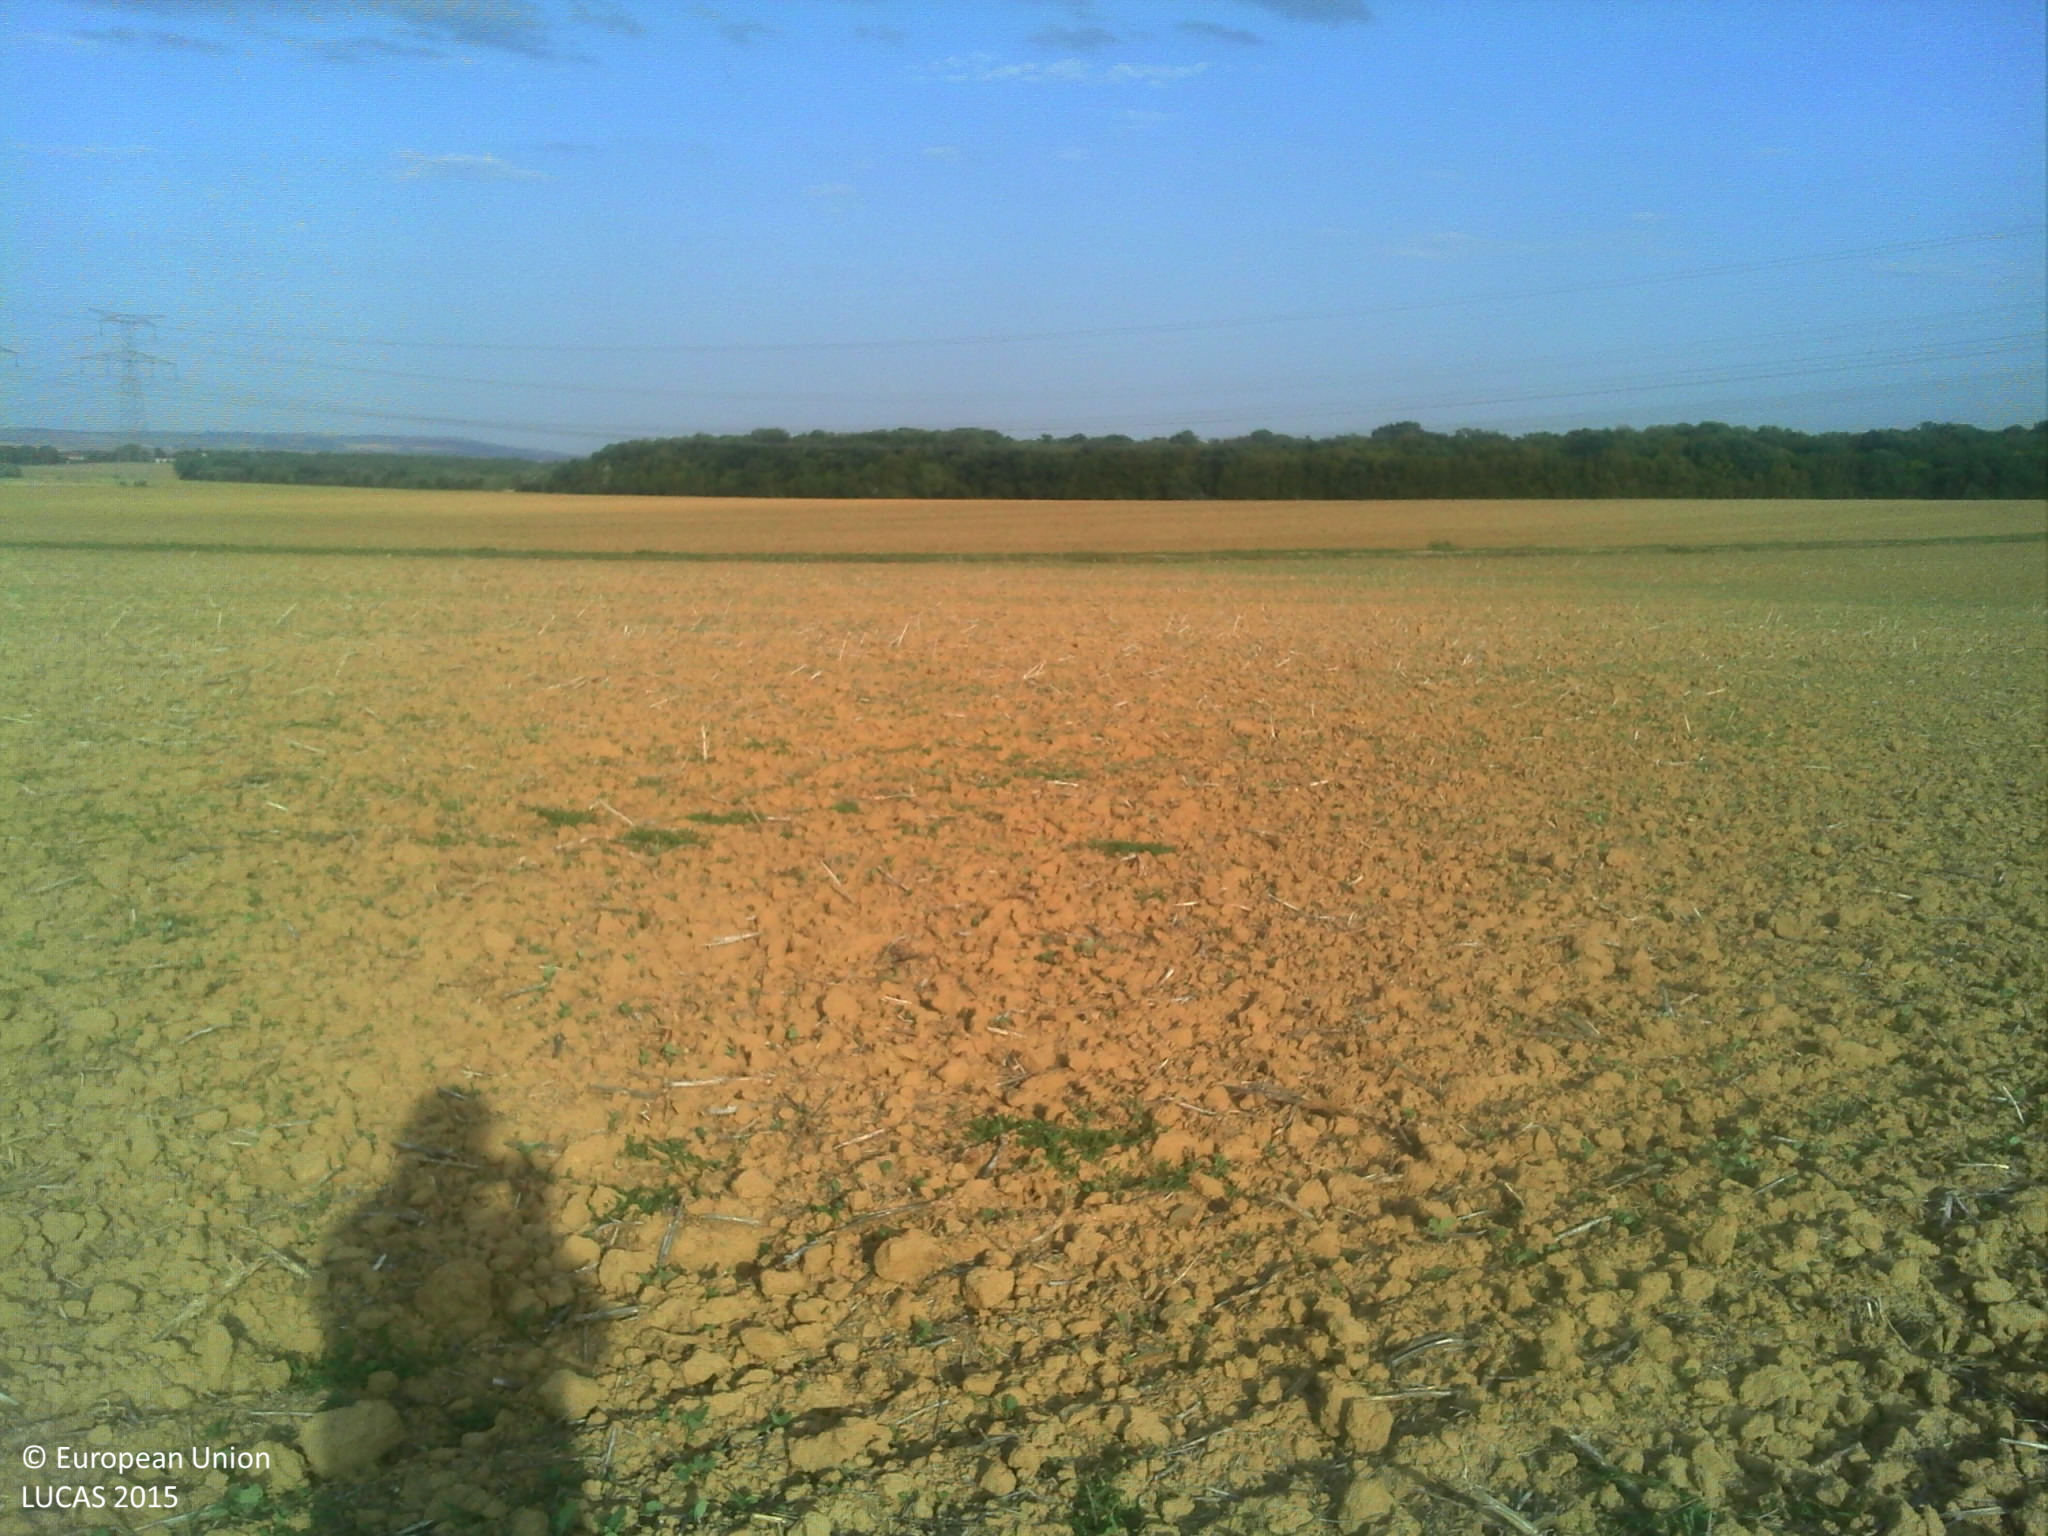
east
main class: Cropland
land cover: Rape and turnip rape
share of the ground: < 10 %
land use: Agriculture (excluding fallow land and kitchen gardens)
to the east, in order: Rape and turnip rape; Tracks; Common wheat
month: August
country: FR
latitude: 48.8765
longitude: 6.1411
